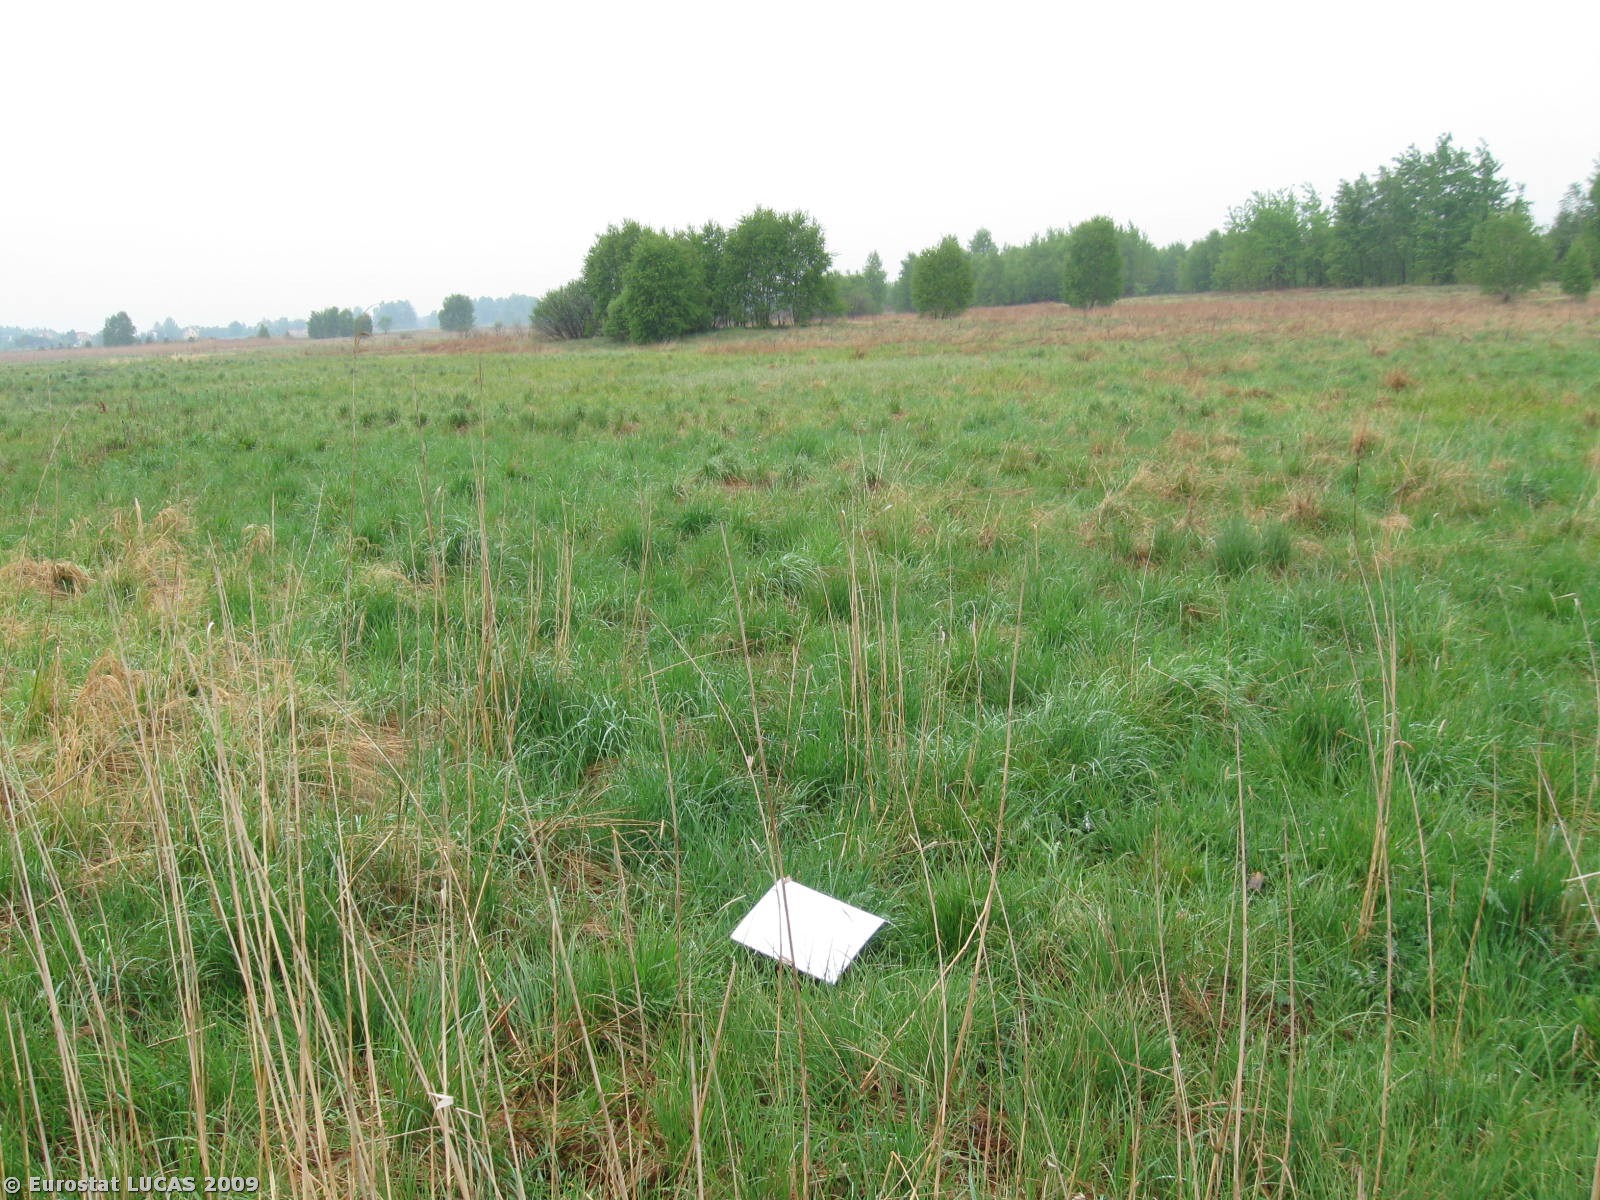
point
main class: Grassland
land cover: Grassland without tree/shrub cover
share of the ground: > 75 %
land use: Unused
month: May
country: PL
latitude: 51.0459
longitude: 20.4359
